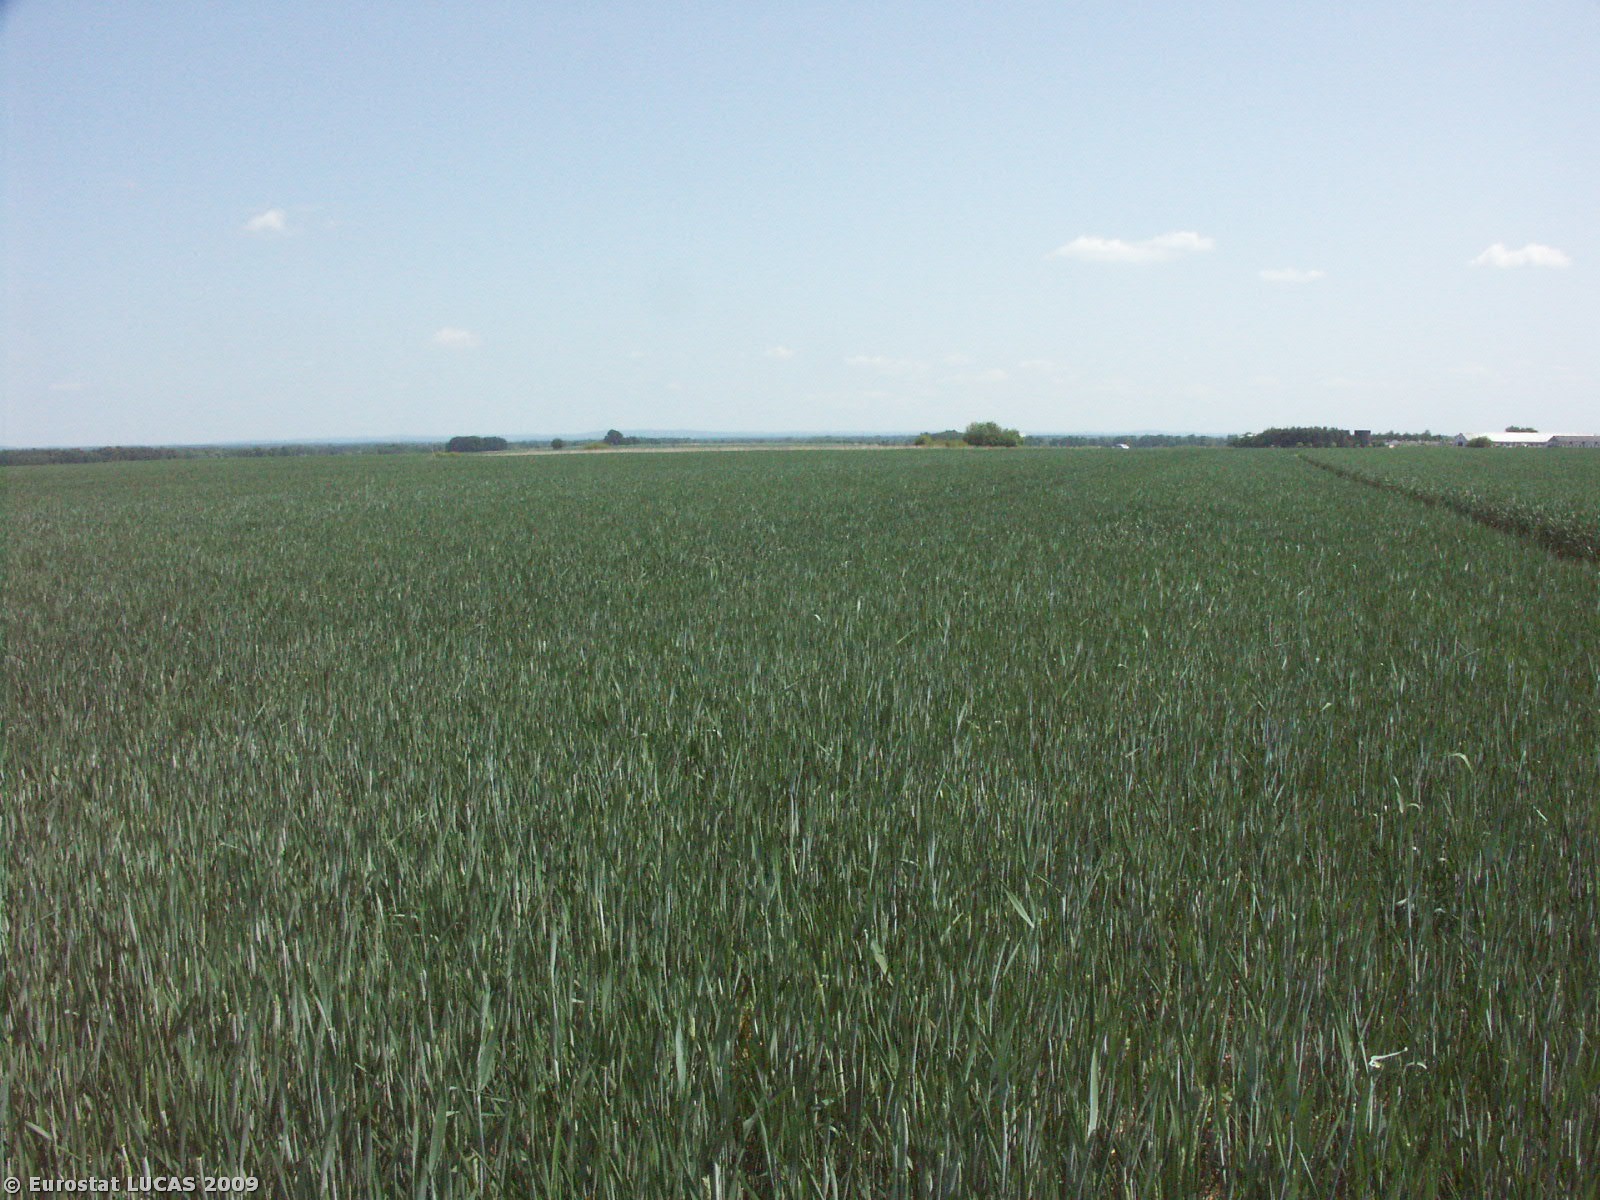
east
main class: Cropland
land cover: Common wheat
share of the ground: > 75 %
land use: Agriculture (excluding fallow land and kitchen gardens)
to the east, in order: Common wheat; Grassland without tree/shrub cover
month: May
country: CZ
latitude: 49.0427
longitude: 14.6940
